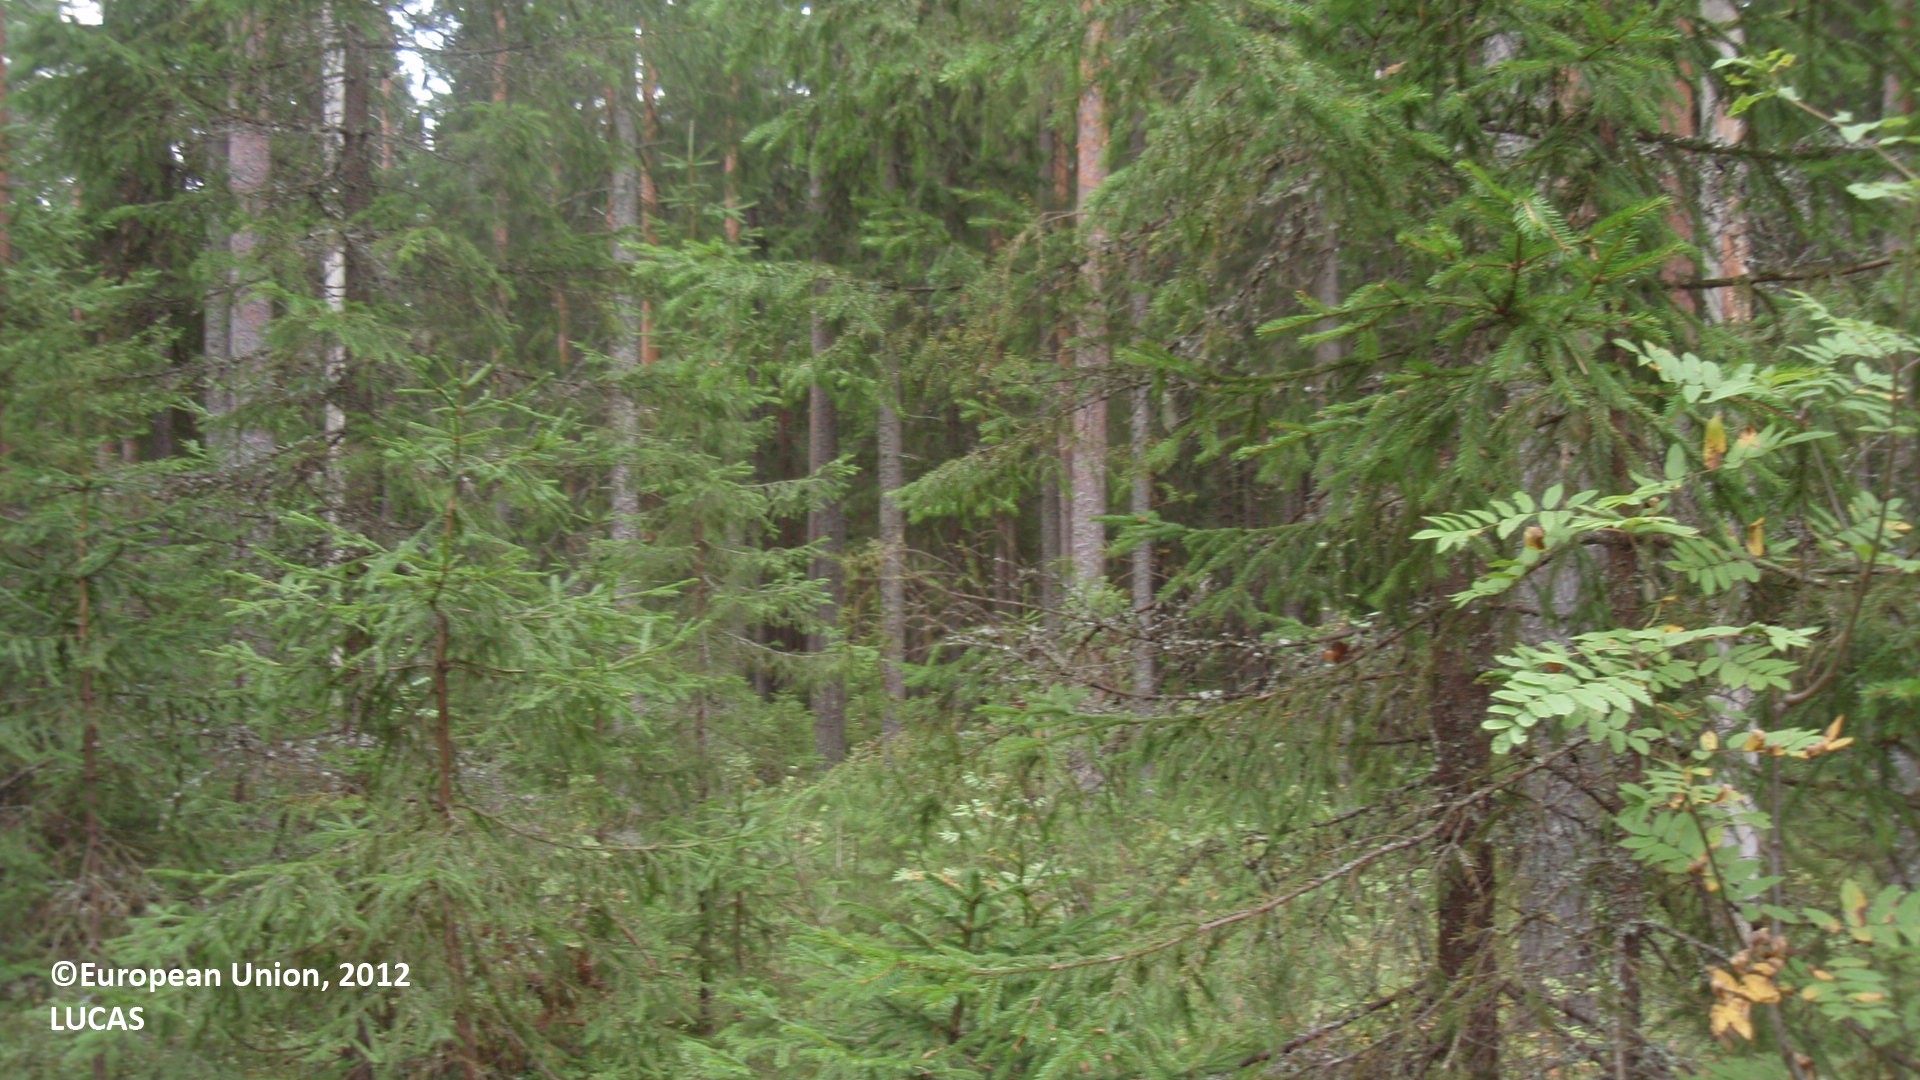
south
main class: Woodland
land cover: Pine dominated mixed woodland
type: boreal forest
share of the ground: 50 - 75 %
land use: Forestry
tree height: > 5 m
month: August
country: FI
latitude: 60.7507
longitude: 27.4097
